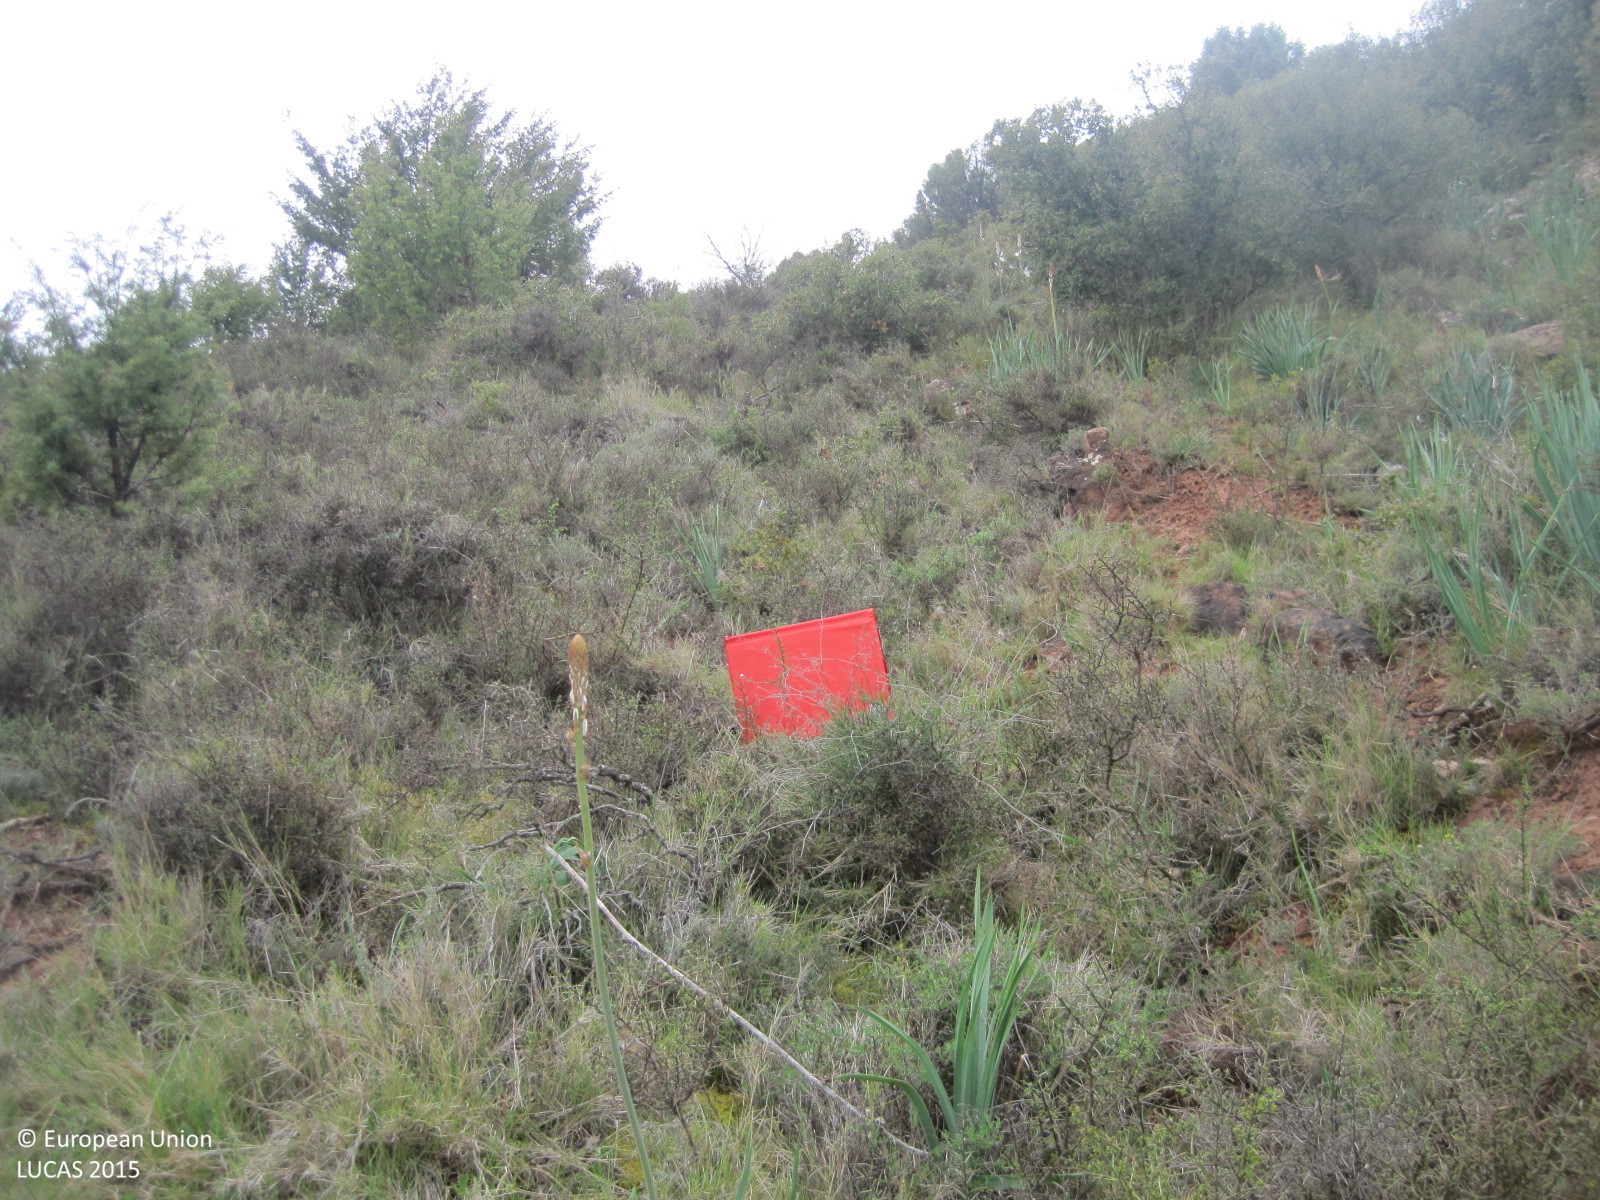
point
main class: Shrubland
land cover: Shrubland with sparse tree cover
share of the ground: > 75 %
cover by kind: shrubs 90 %, coniferous forest trees 5 %, unconsolidated bare surface 5 %
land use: Semi-natural and natural areas not in use
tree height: > 5 m
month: April
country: ES
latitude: 42.6131
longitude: -2.1479
